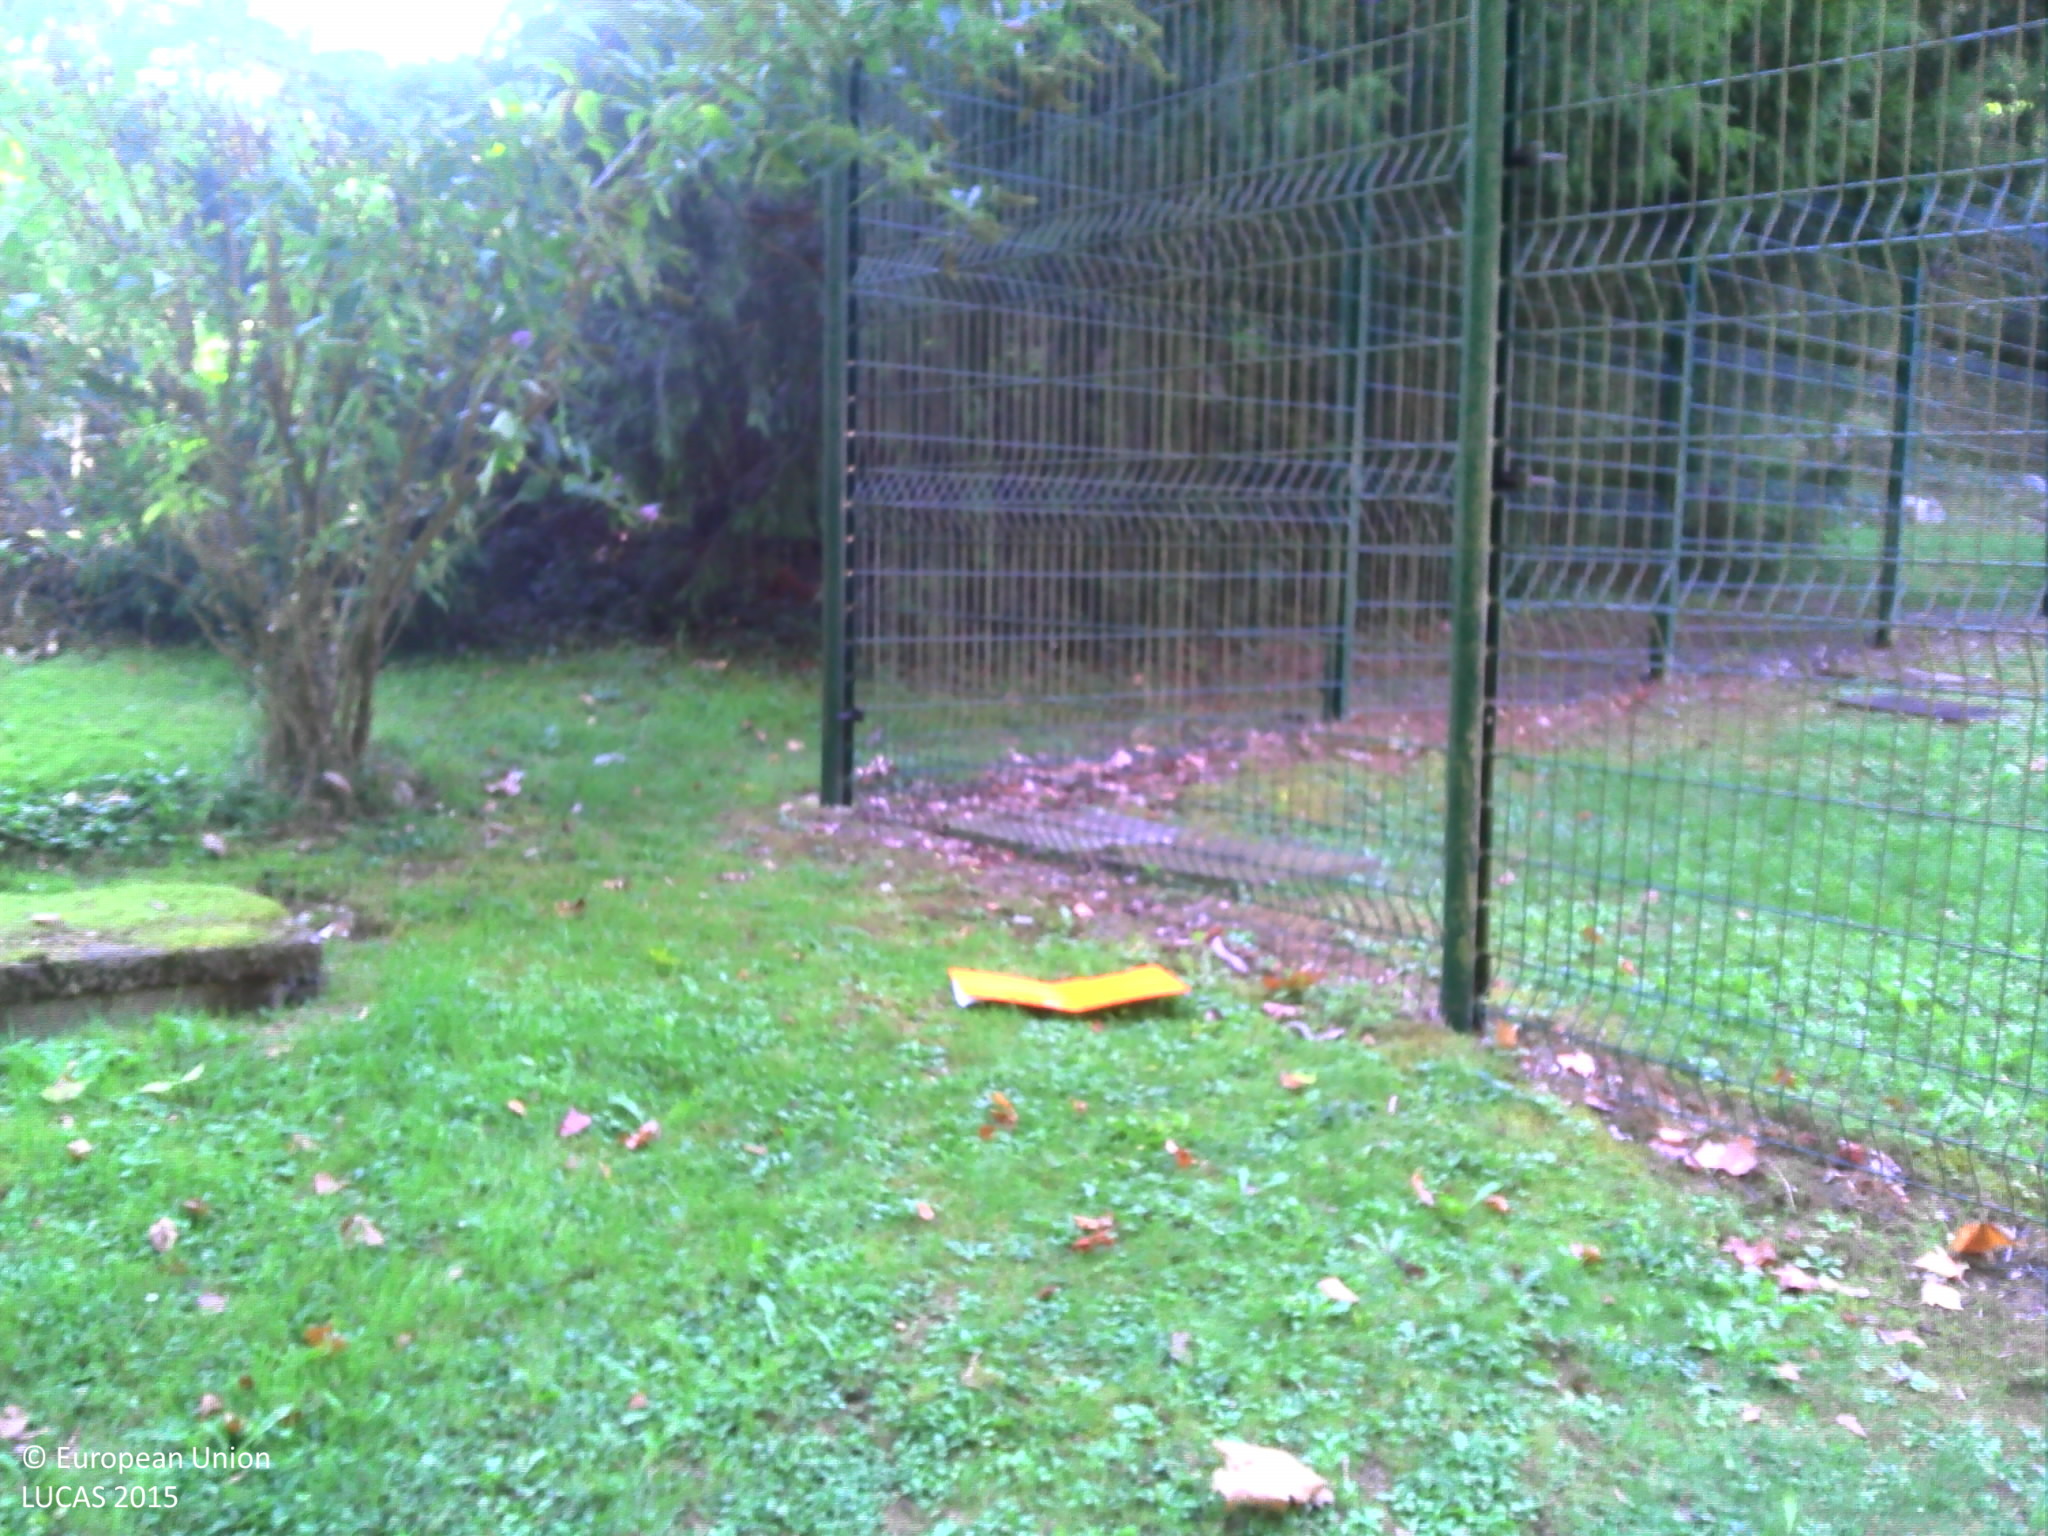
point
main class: Grassland
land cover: Grassland without tree/shrub cover
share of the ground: > 75 %
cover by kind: herbaceous plants 70 %, consolidated bare surface 10 %
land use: Amenities, museums, leisure
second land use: Sport
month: September
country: FR
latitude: 47.3228
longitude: 6.0191
